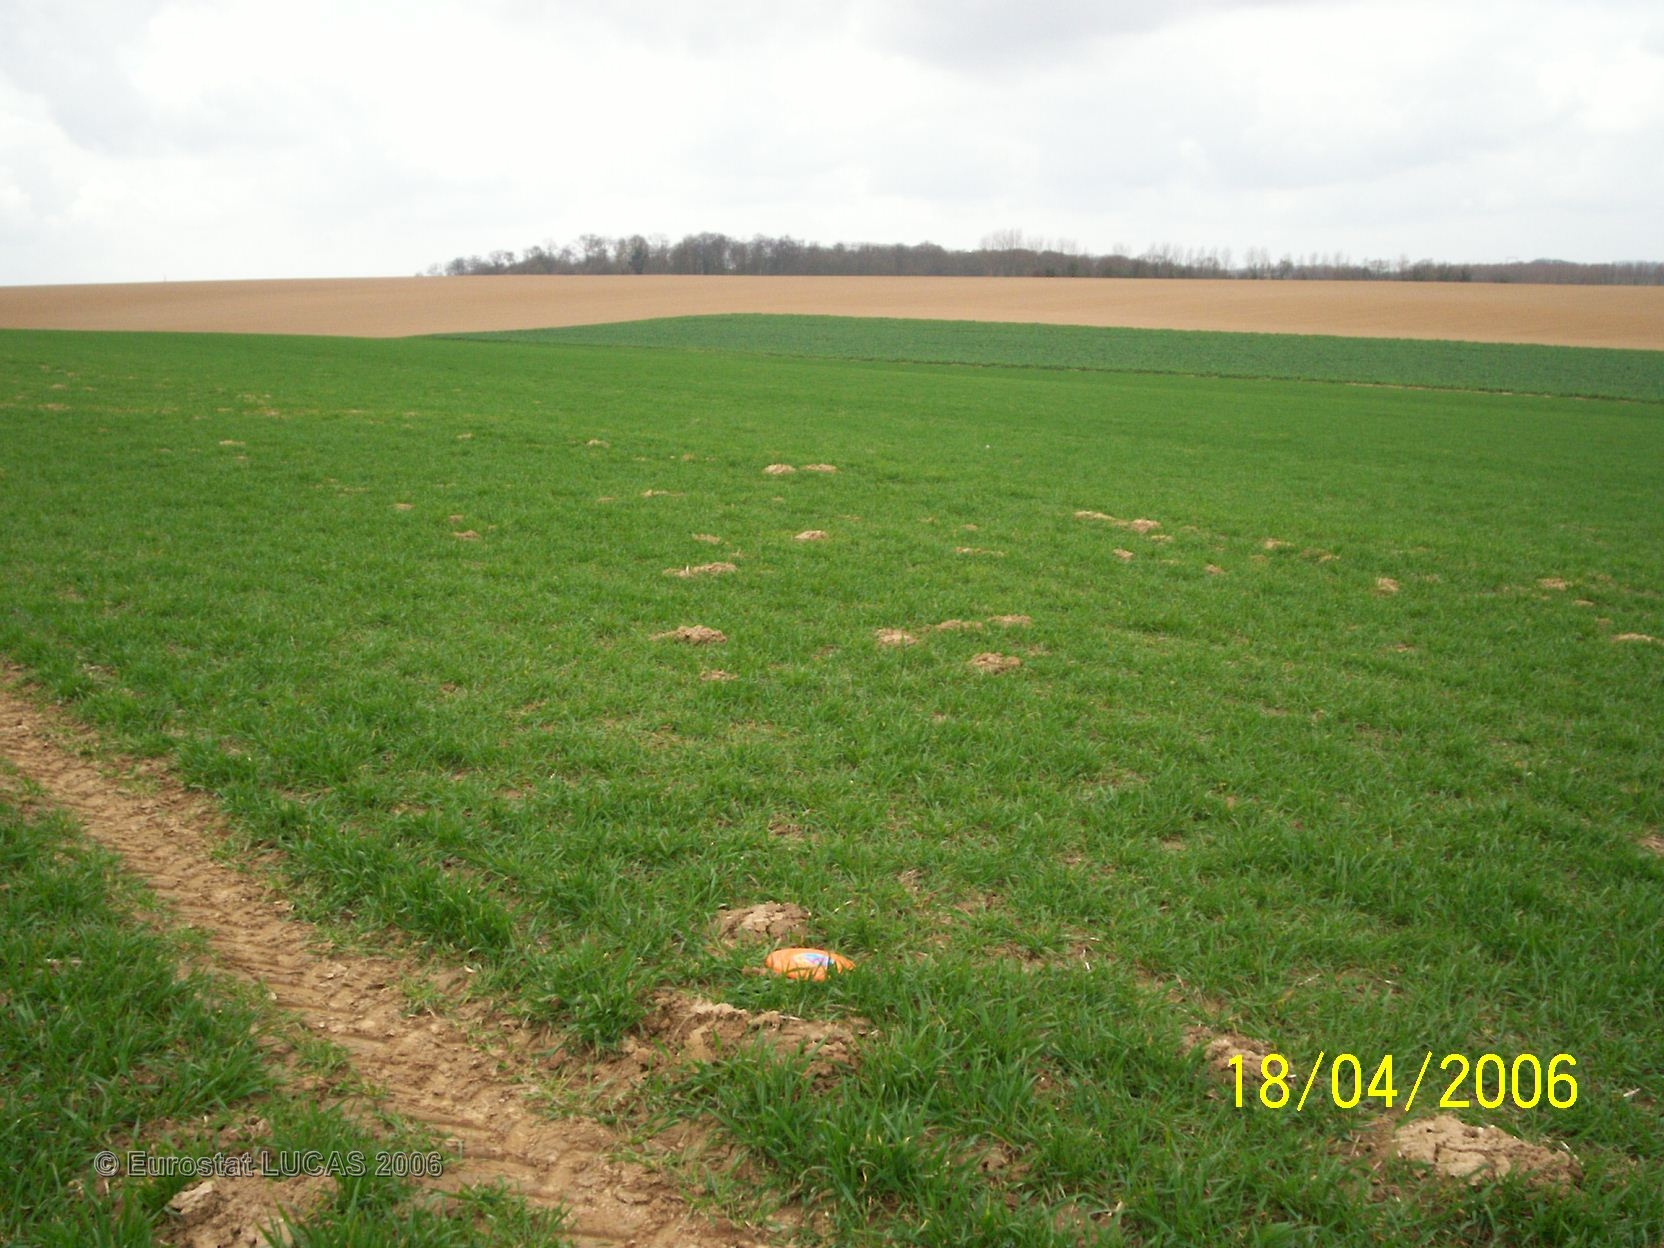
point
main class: Cropland
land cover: Common wheat
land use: Agriculture (excluding fallow land and kitchen gardens)
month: April
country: FR
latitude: 50.3380
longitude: 2.5552
